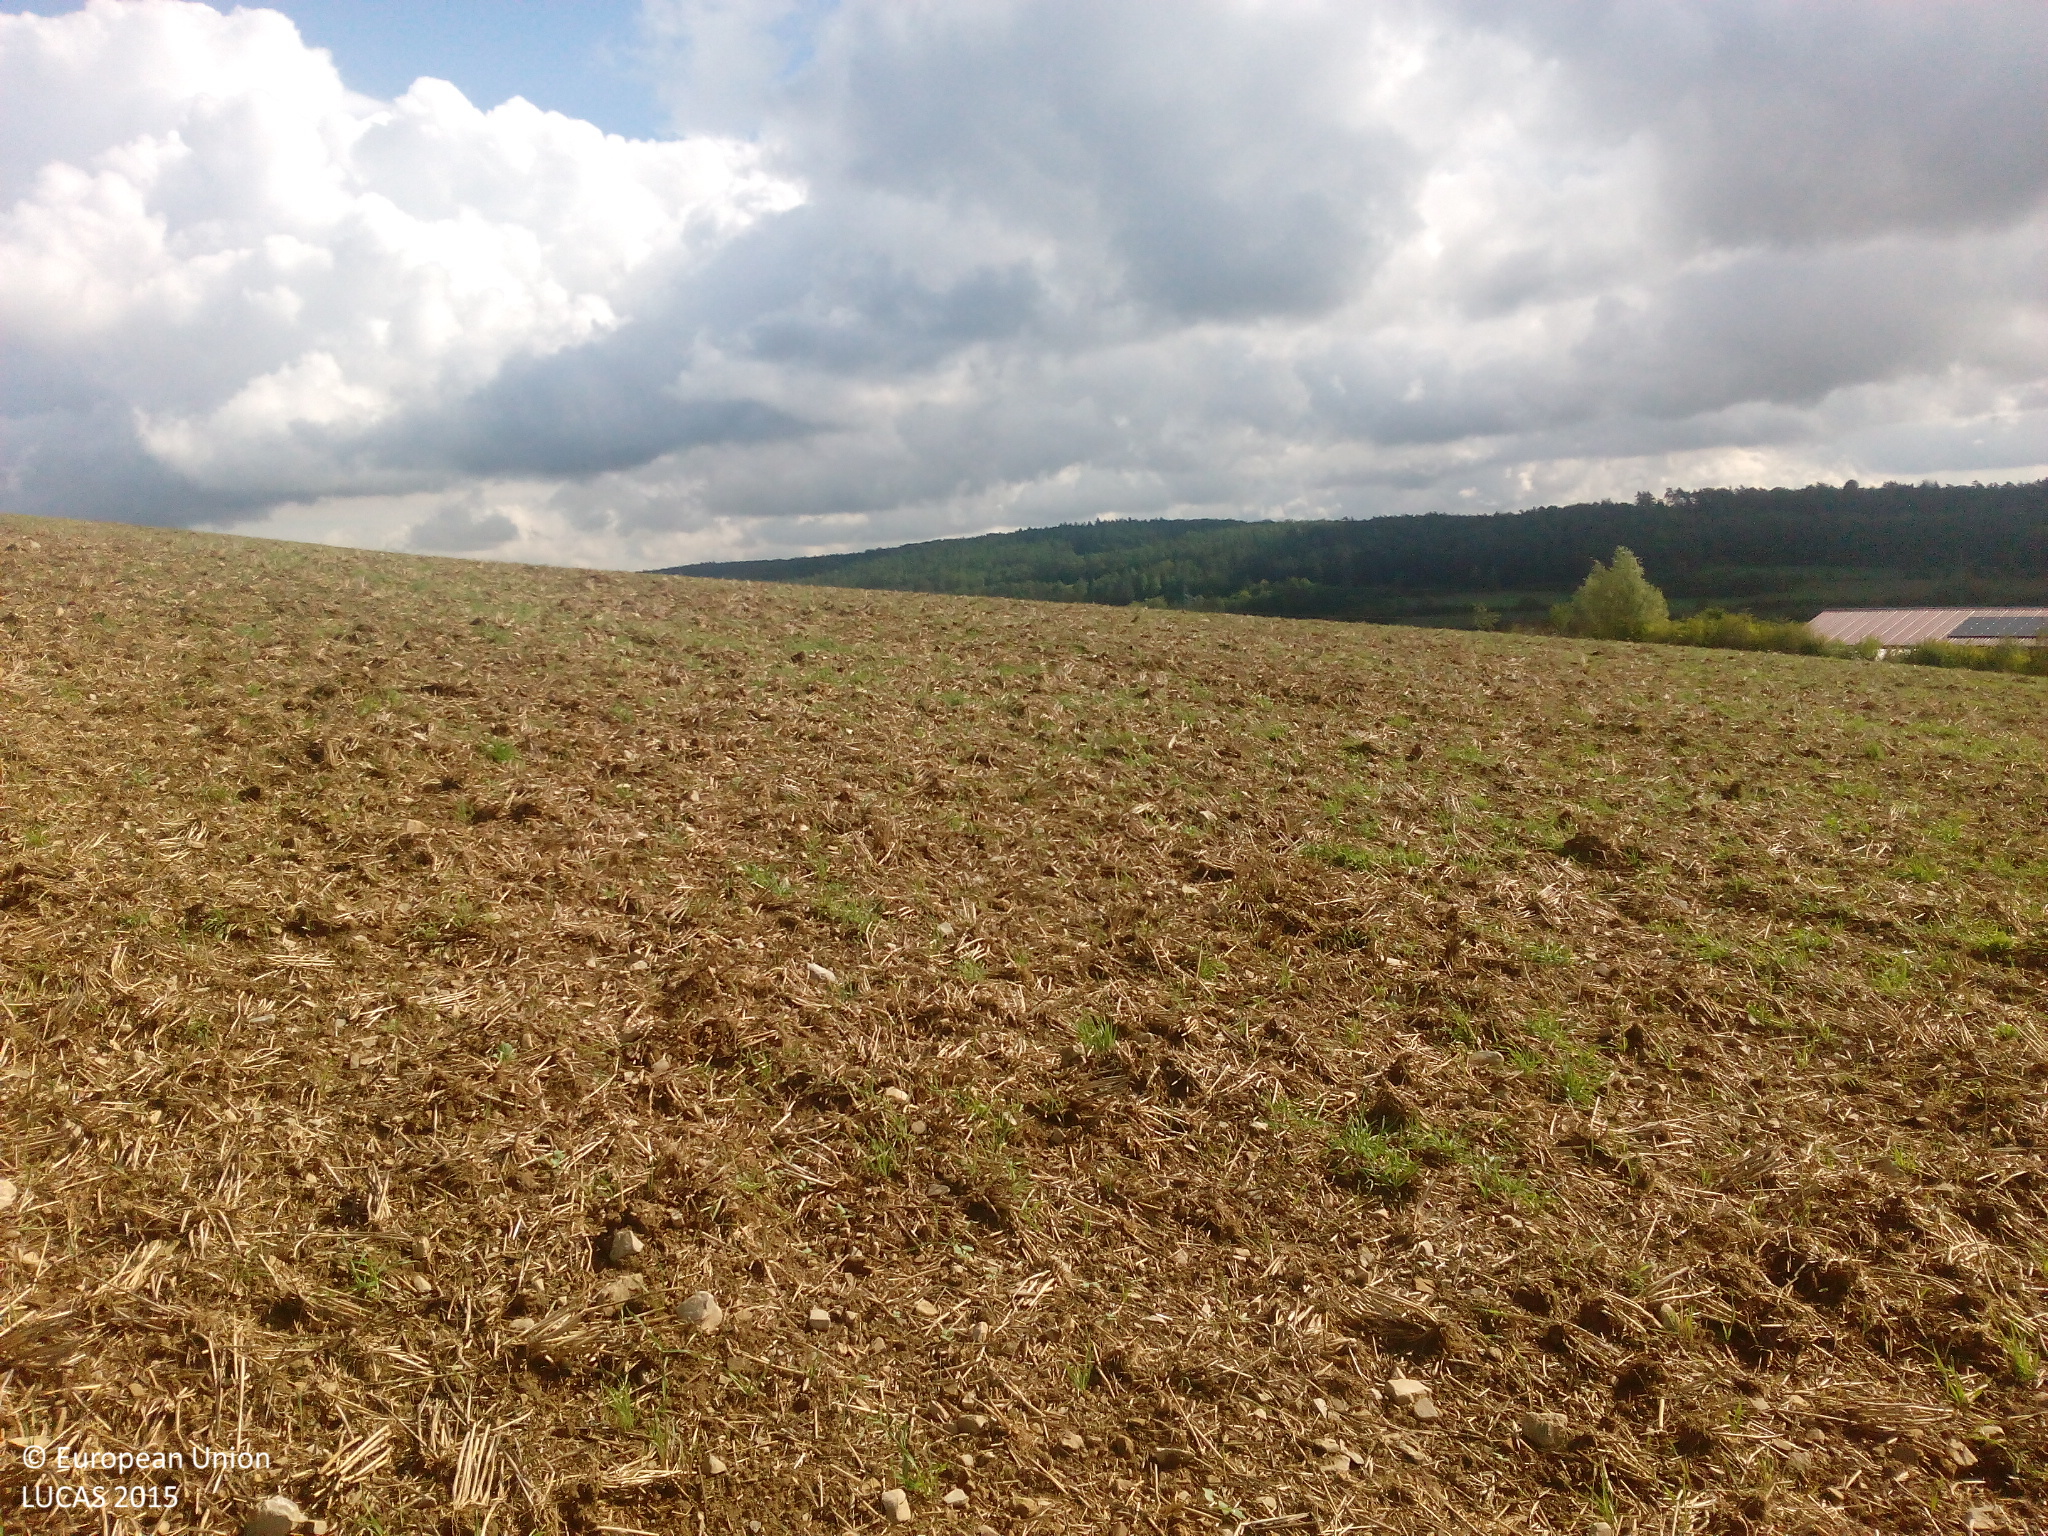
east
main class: Cropland
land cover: Common wheat
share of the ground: 10 - 25 %
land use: Agriculture (excluding fallow land and kitchen gardens)
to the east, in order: Common wheat; Grass margins; Tracks; Barley
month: September
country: DE
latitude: 49.8785
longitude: 9.9026
